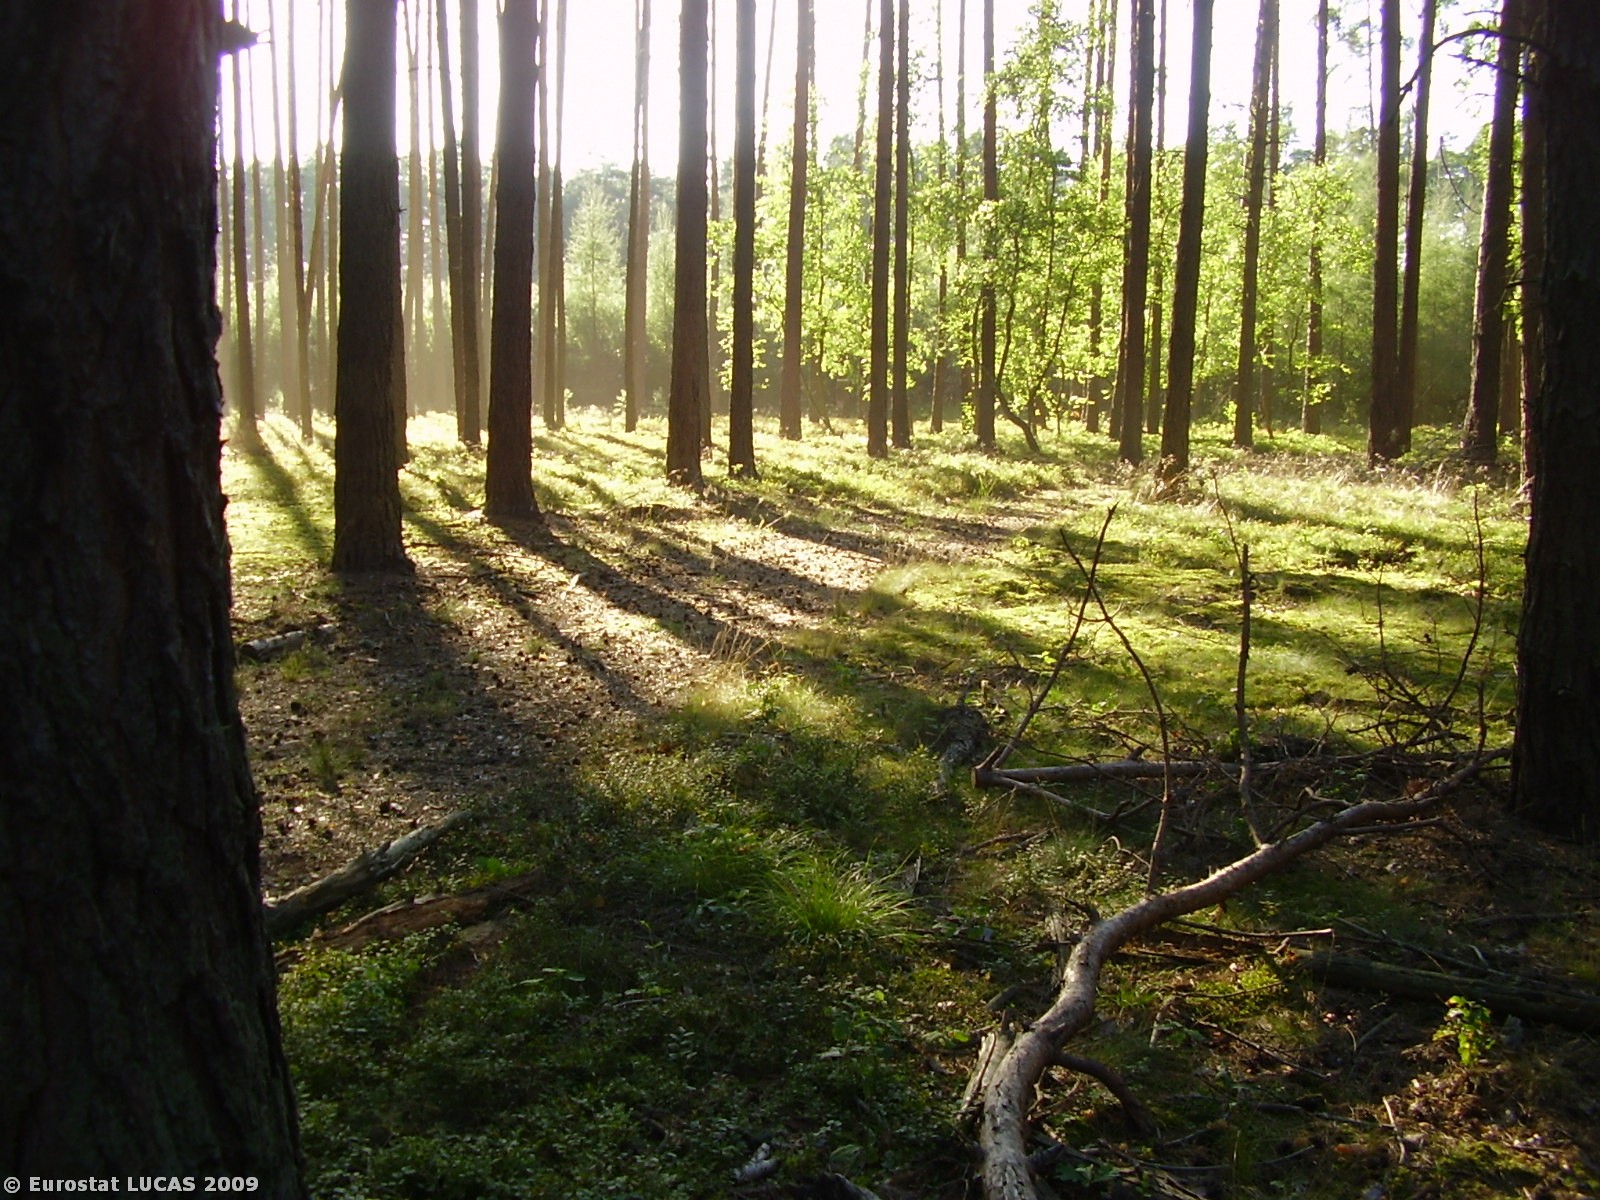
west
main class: Woodland
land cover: Mixed woodland
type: hemiboreal forest and nemoral coniferous forest and mixed broadleaved-coniferous forest
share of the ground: > 75 %
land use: Forestry
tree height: > 5 m
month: September
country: PL
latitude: 51.8857
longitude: 16.2978
